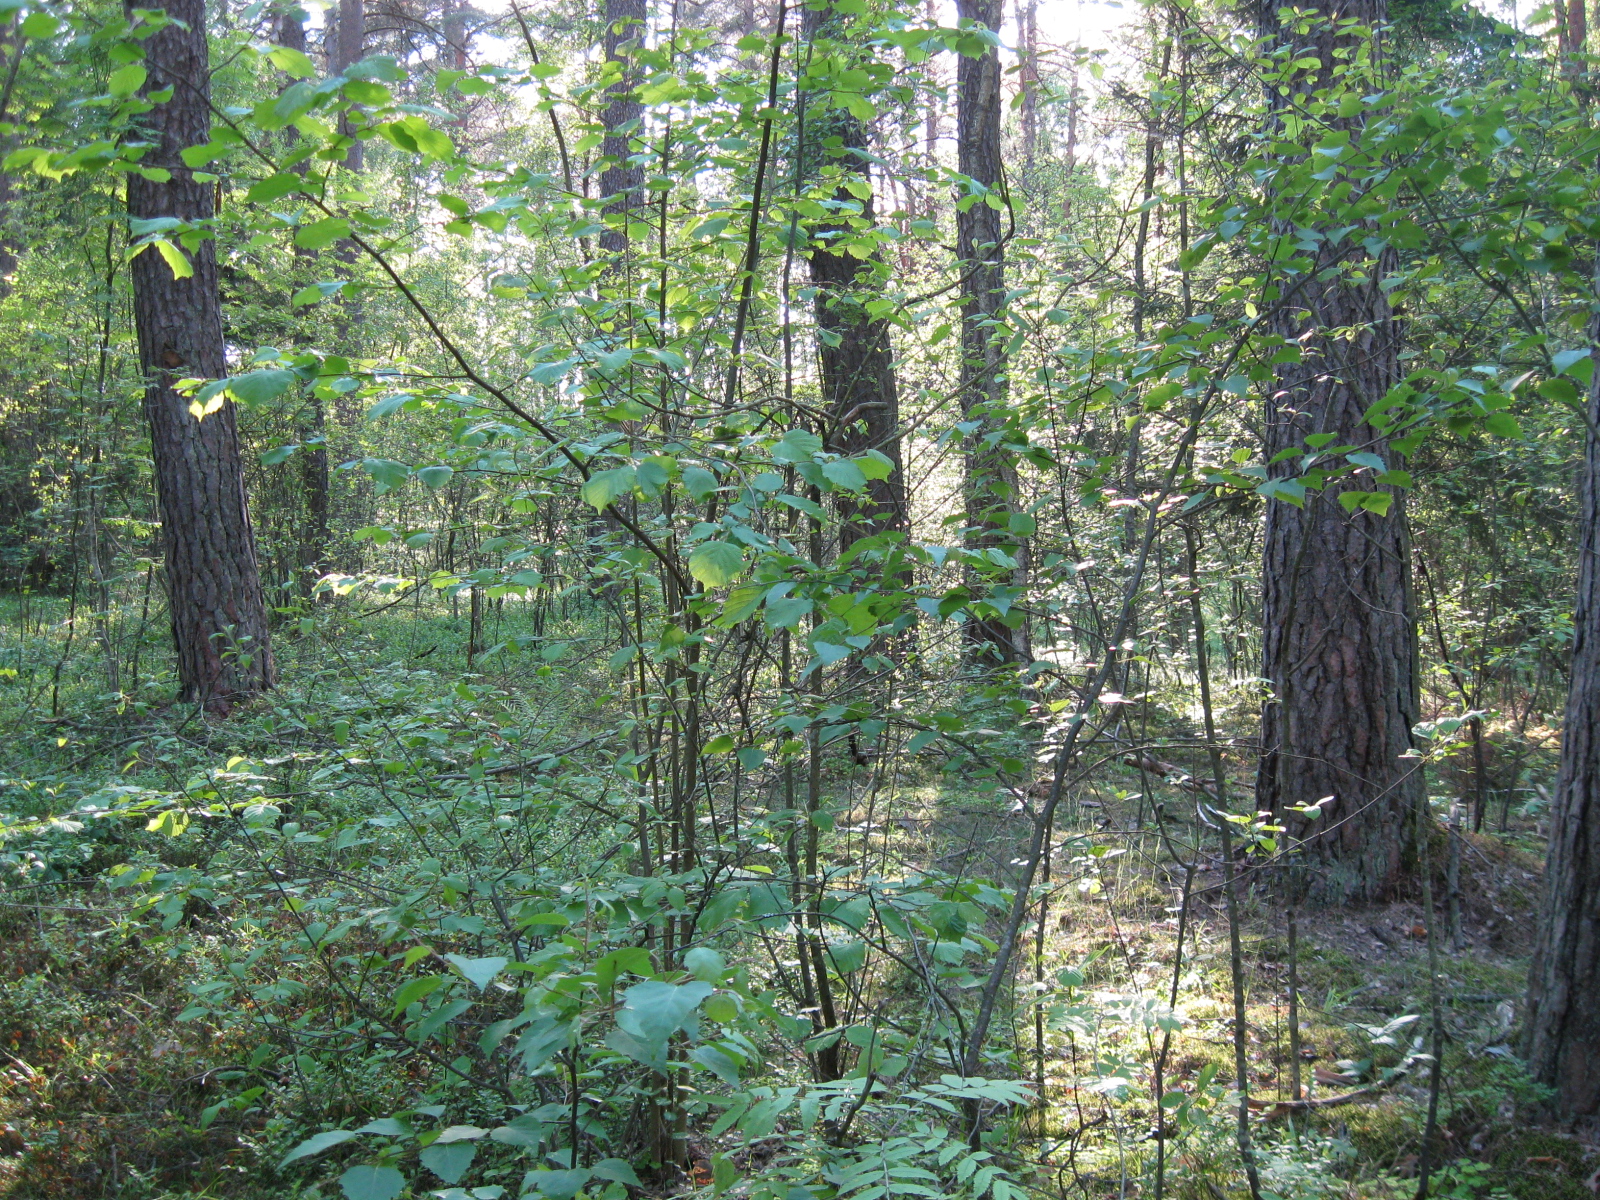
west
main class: Woodland
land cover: Pine dominated mixed woodland
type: hemiboreal forest and nemoral coniferous forest and mixed broadleaved-coniferous forest
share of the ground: > 75 %
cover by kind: coniferous forest trees 60 %, broadleaved forest trees 30 %, herbaceous plants 10 %
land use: Forestry
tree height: > 5 m
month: June
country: LT
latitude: 54.1308
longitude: 23.7227
